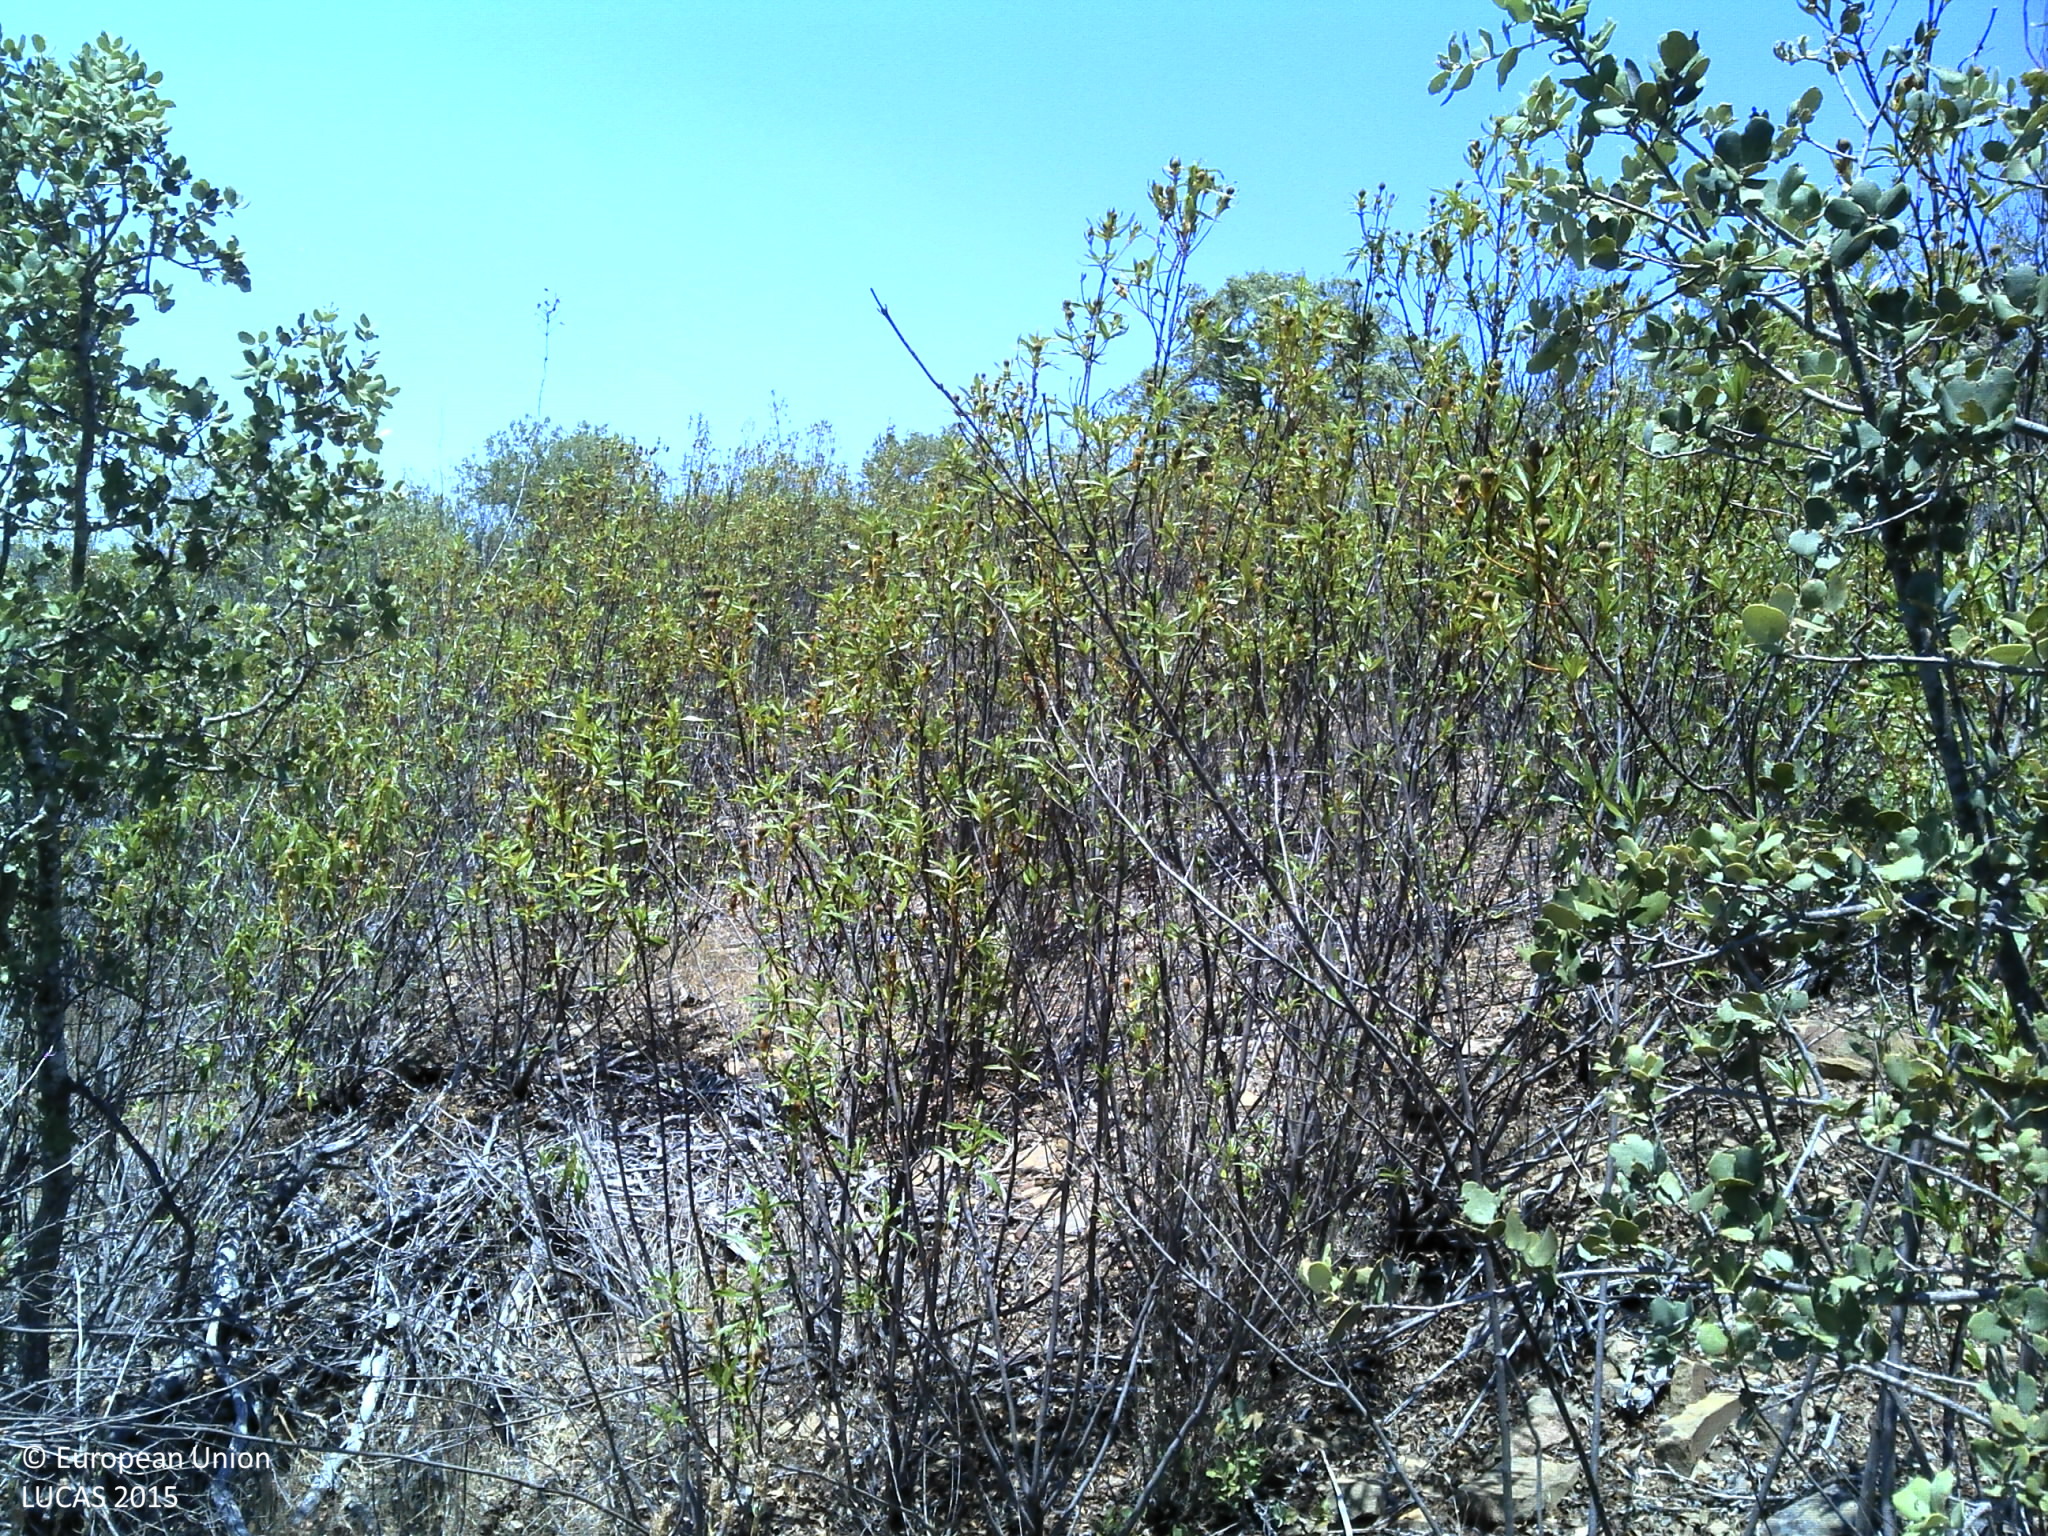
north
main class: Shrubland
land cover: Shrubland without tree cover
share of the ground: > 75 %
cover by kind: shrubs 100 %
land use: Abandoned areas
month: June
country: PT
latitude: 37.4040
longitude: -7.8994
